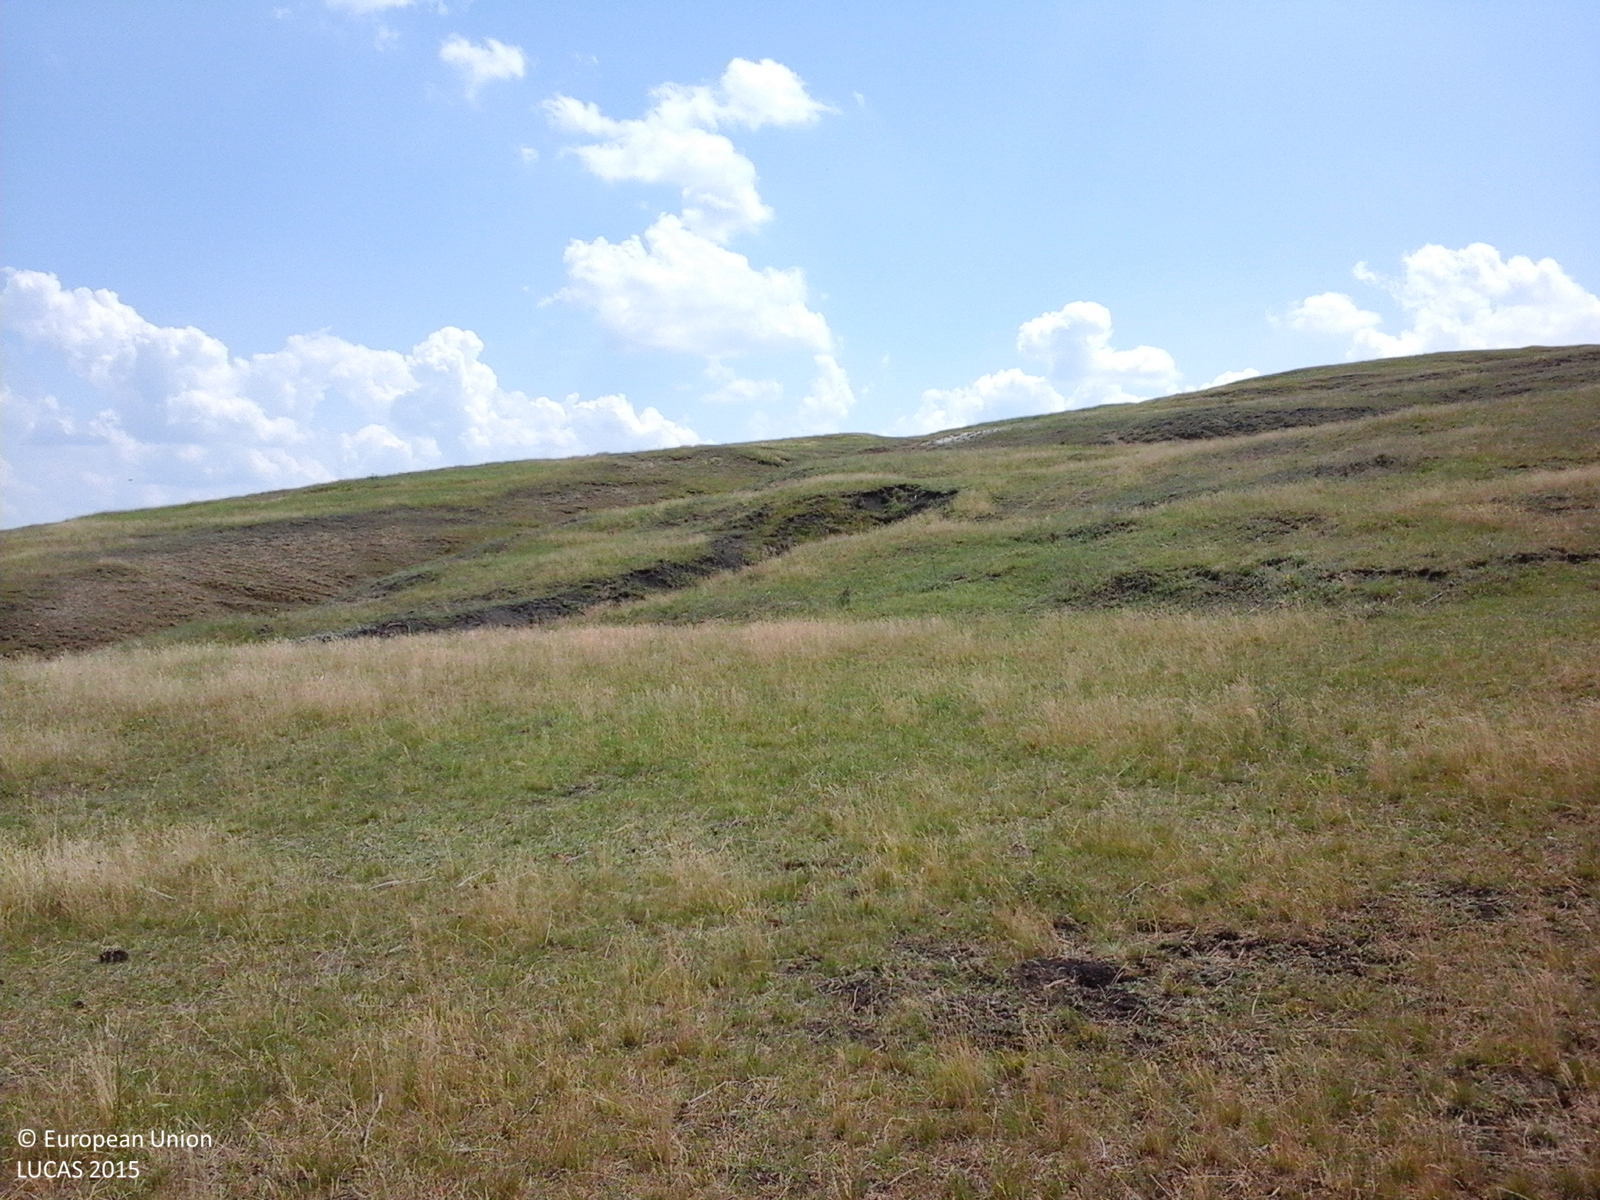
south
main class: Grassland
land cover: Grassland without tree/shrub cover
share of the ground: > 75 %
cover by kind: herbaceous plants 100 %
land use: Agriculture (excluding fallow land and kitchen gardens)
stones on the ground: < 10 %
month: June
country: RO
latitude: 47.6014
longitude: 27.0368
